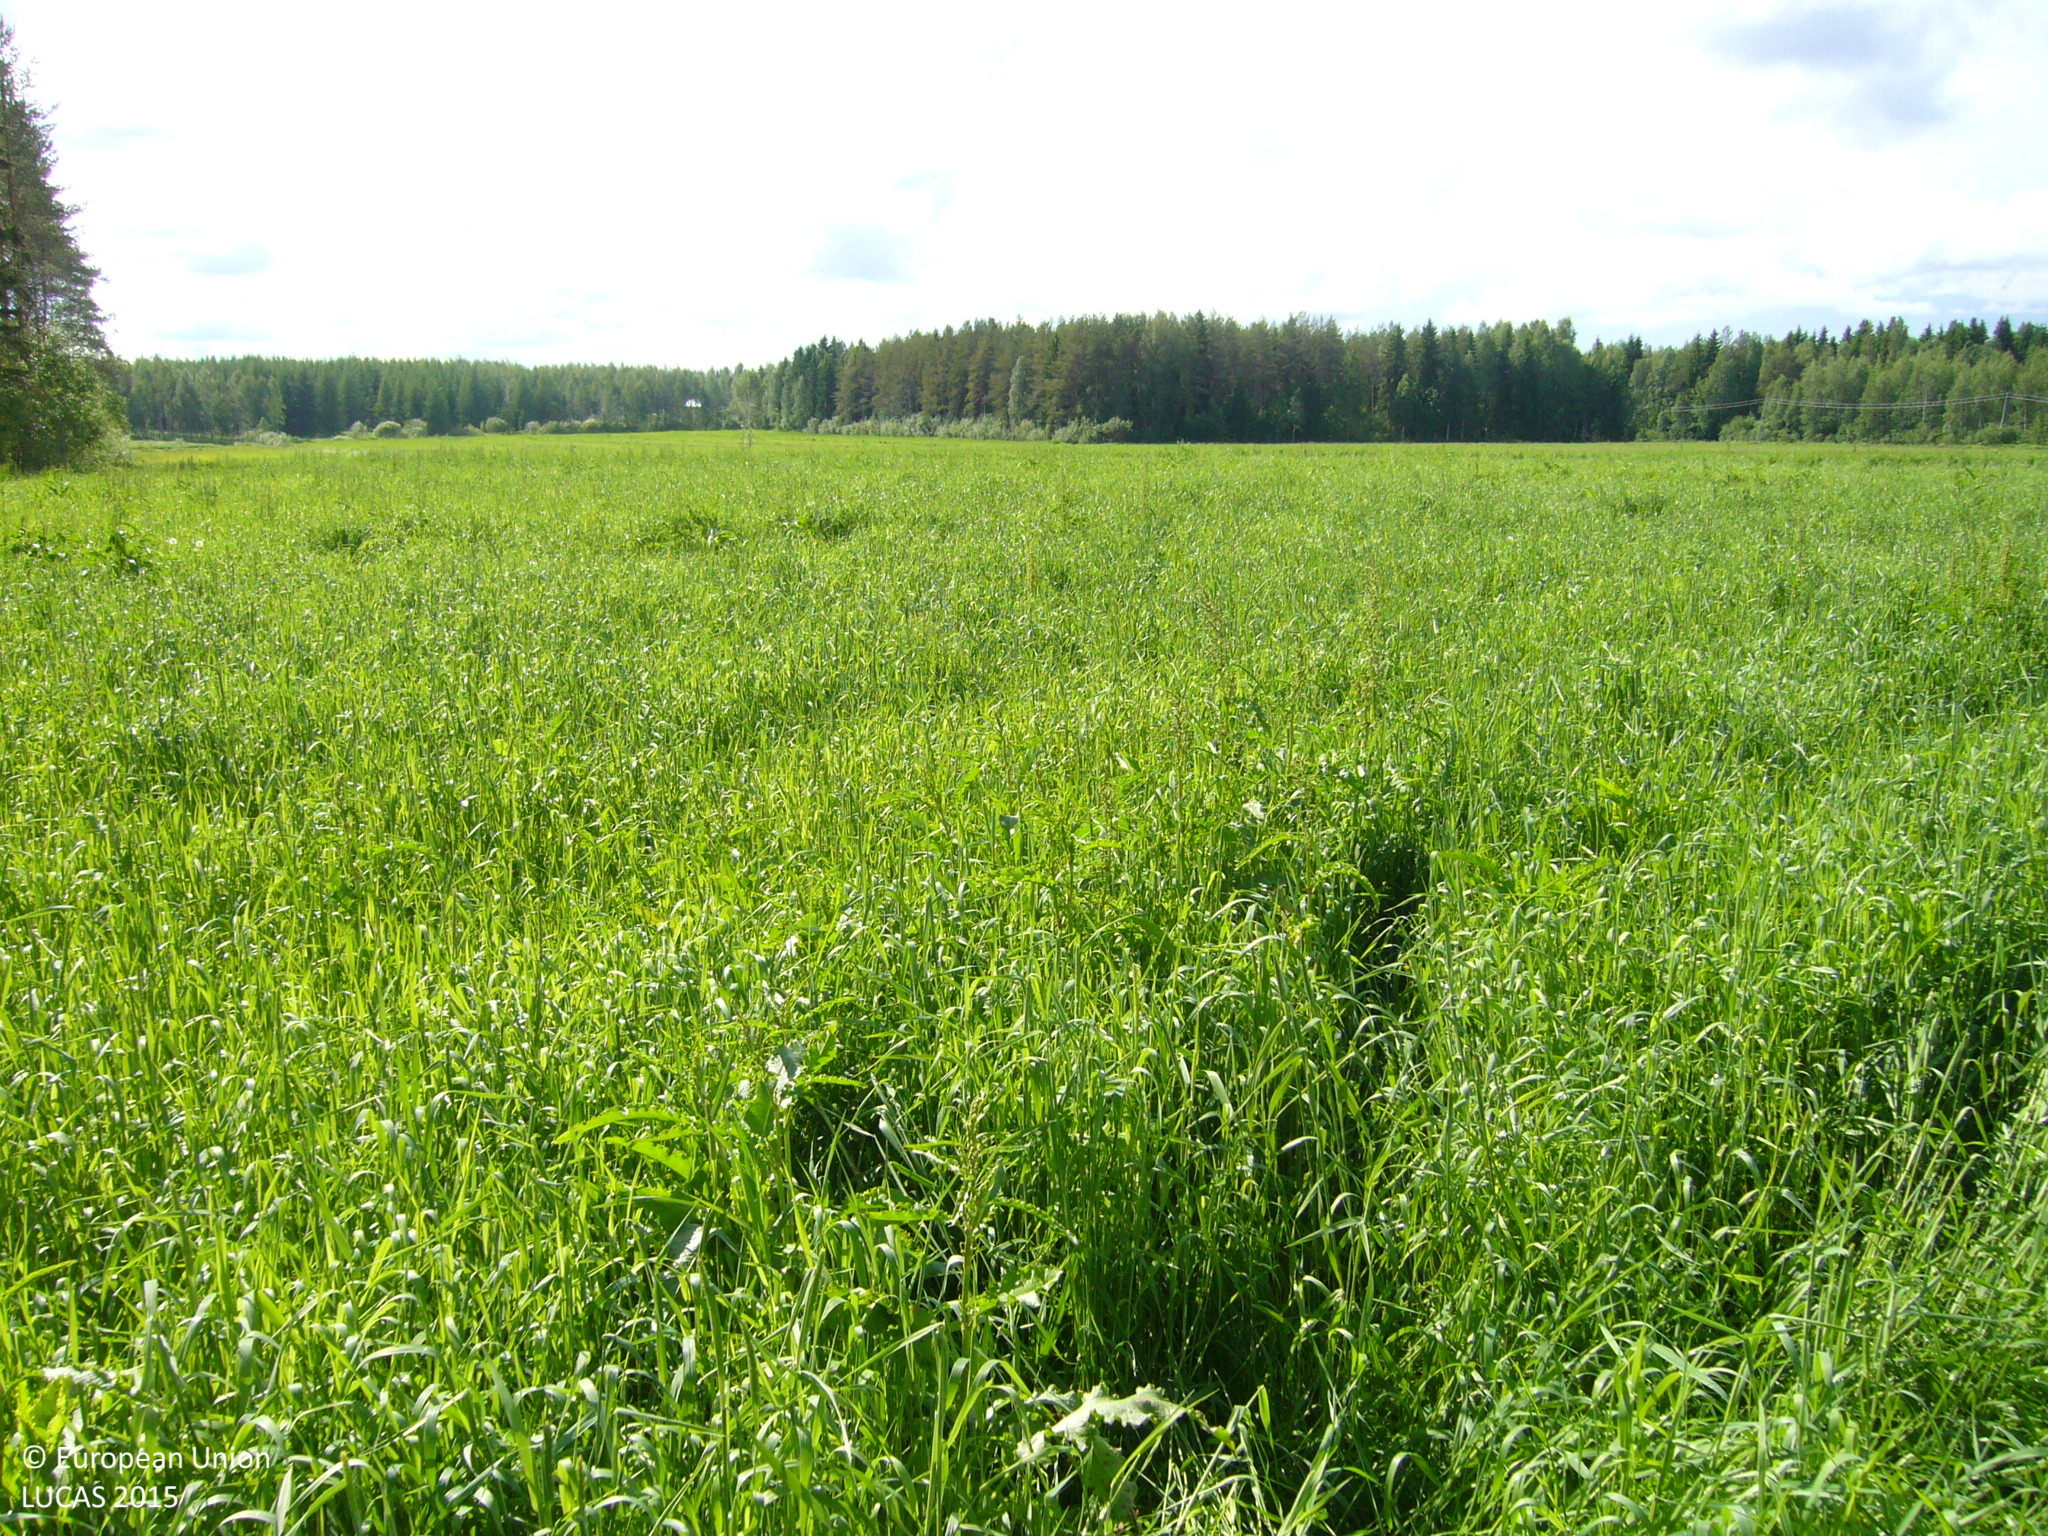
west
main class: Cropland
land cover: Temporary grasslands
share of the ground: > 75 %
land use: Agriculture (excluding fallow land and kitchen gardens)
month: June
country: FI
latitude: 63.7842
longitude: 26.3302
